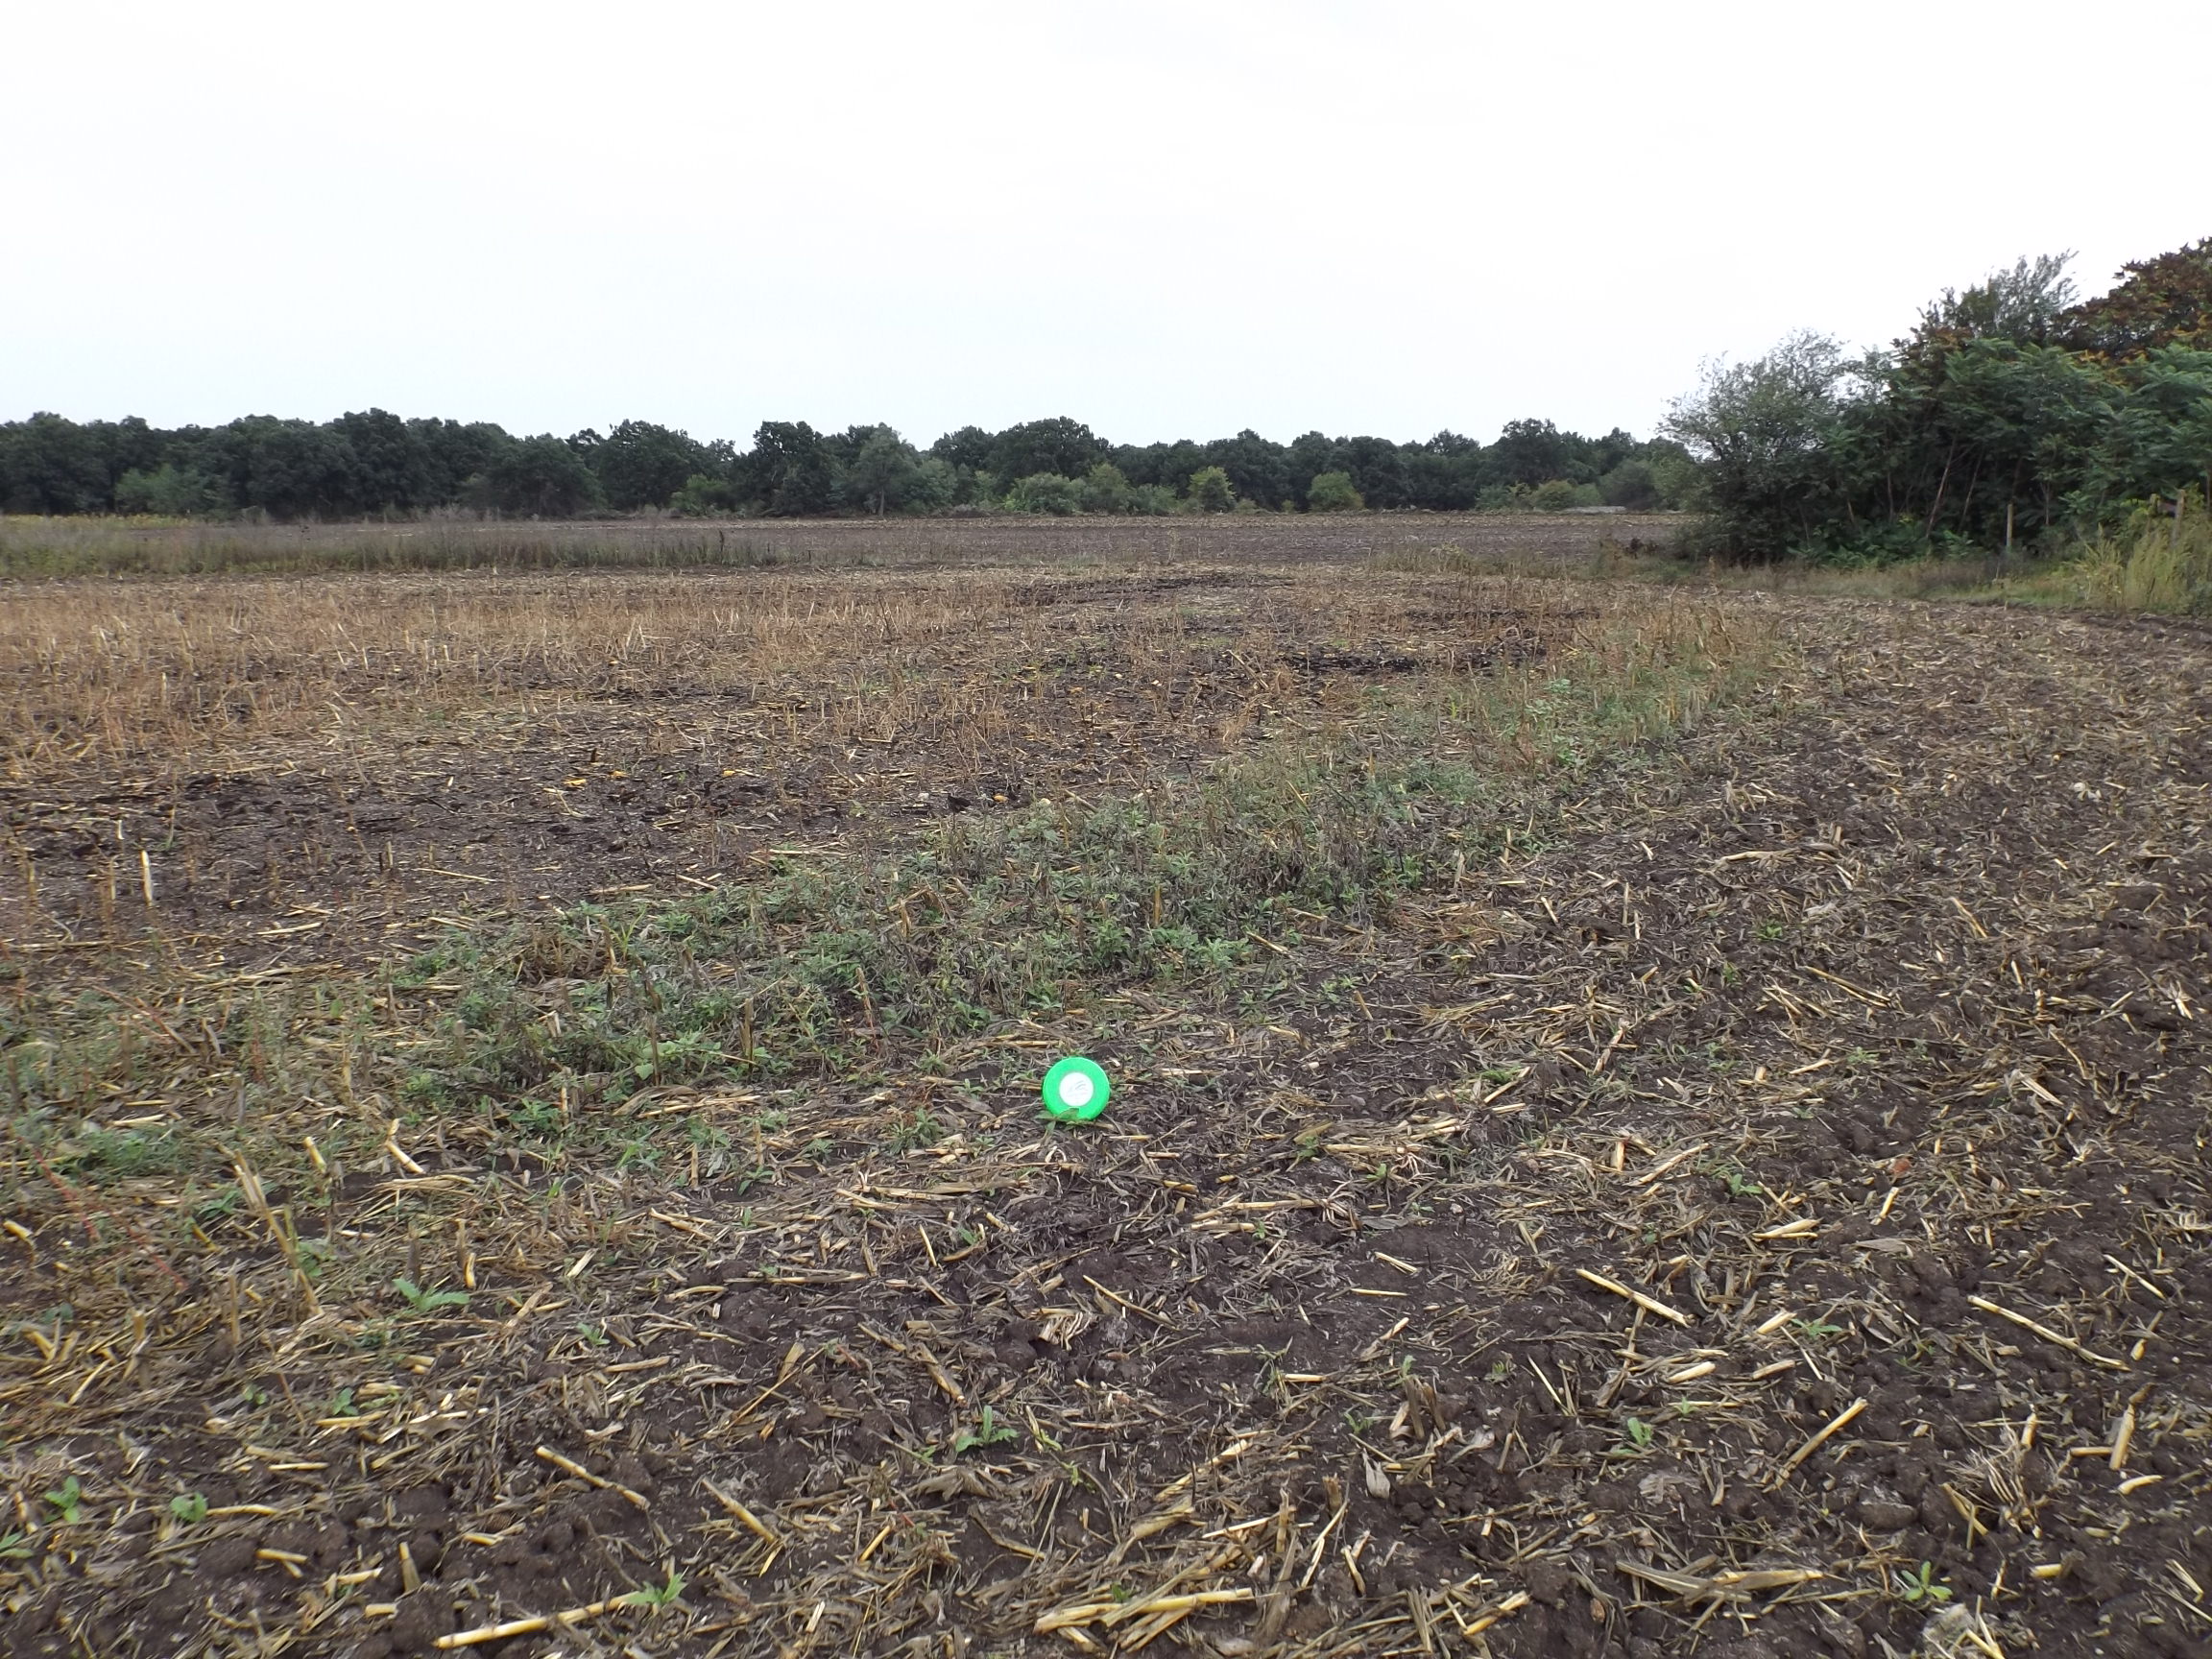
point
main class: Cropland
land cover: Maize
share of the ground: < 10 %
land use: Agriculture (excluding fallow land and kitchen gardens)
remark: Harvested field
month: September
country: BG
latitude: 43.5631
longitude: 27.5270
